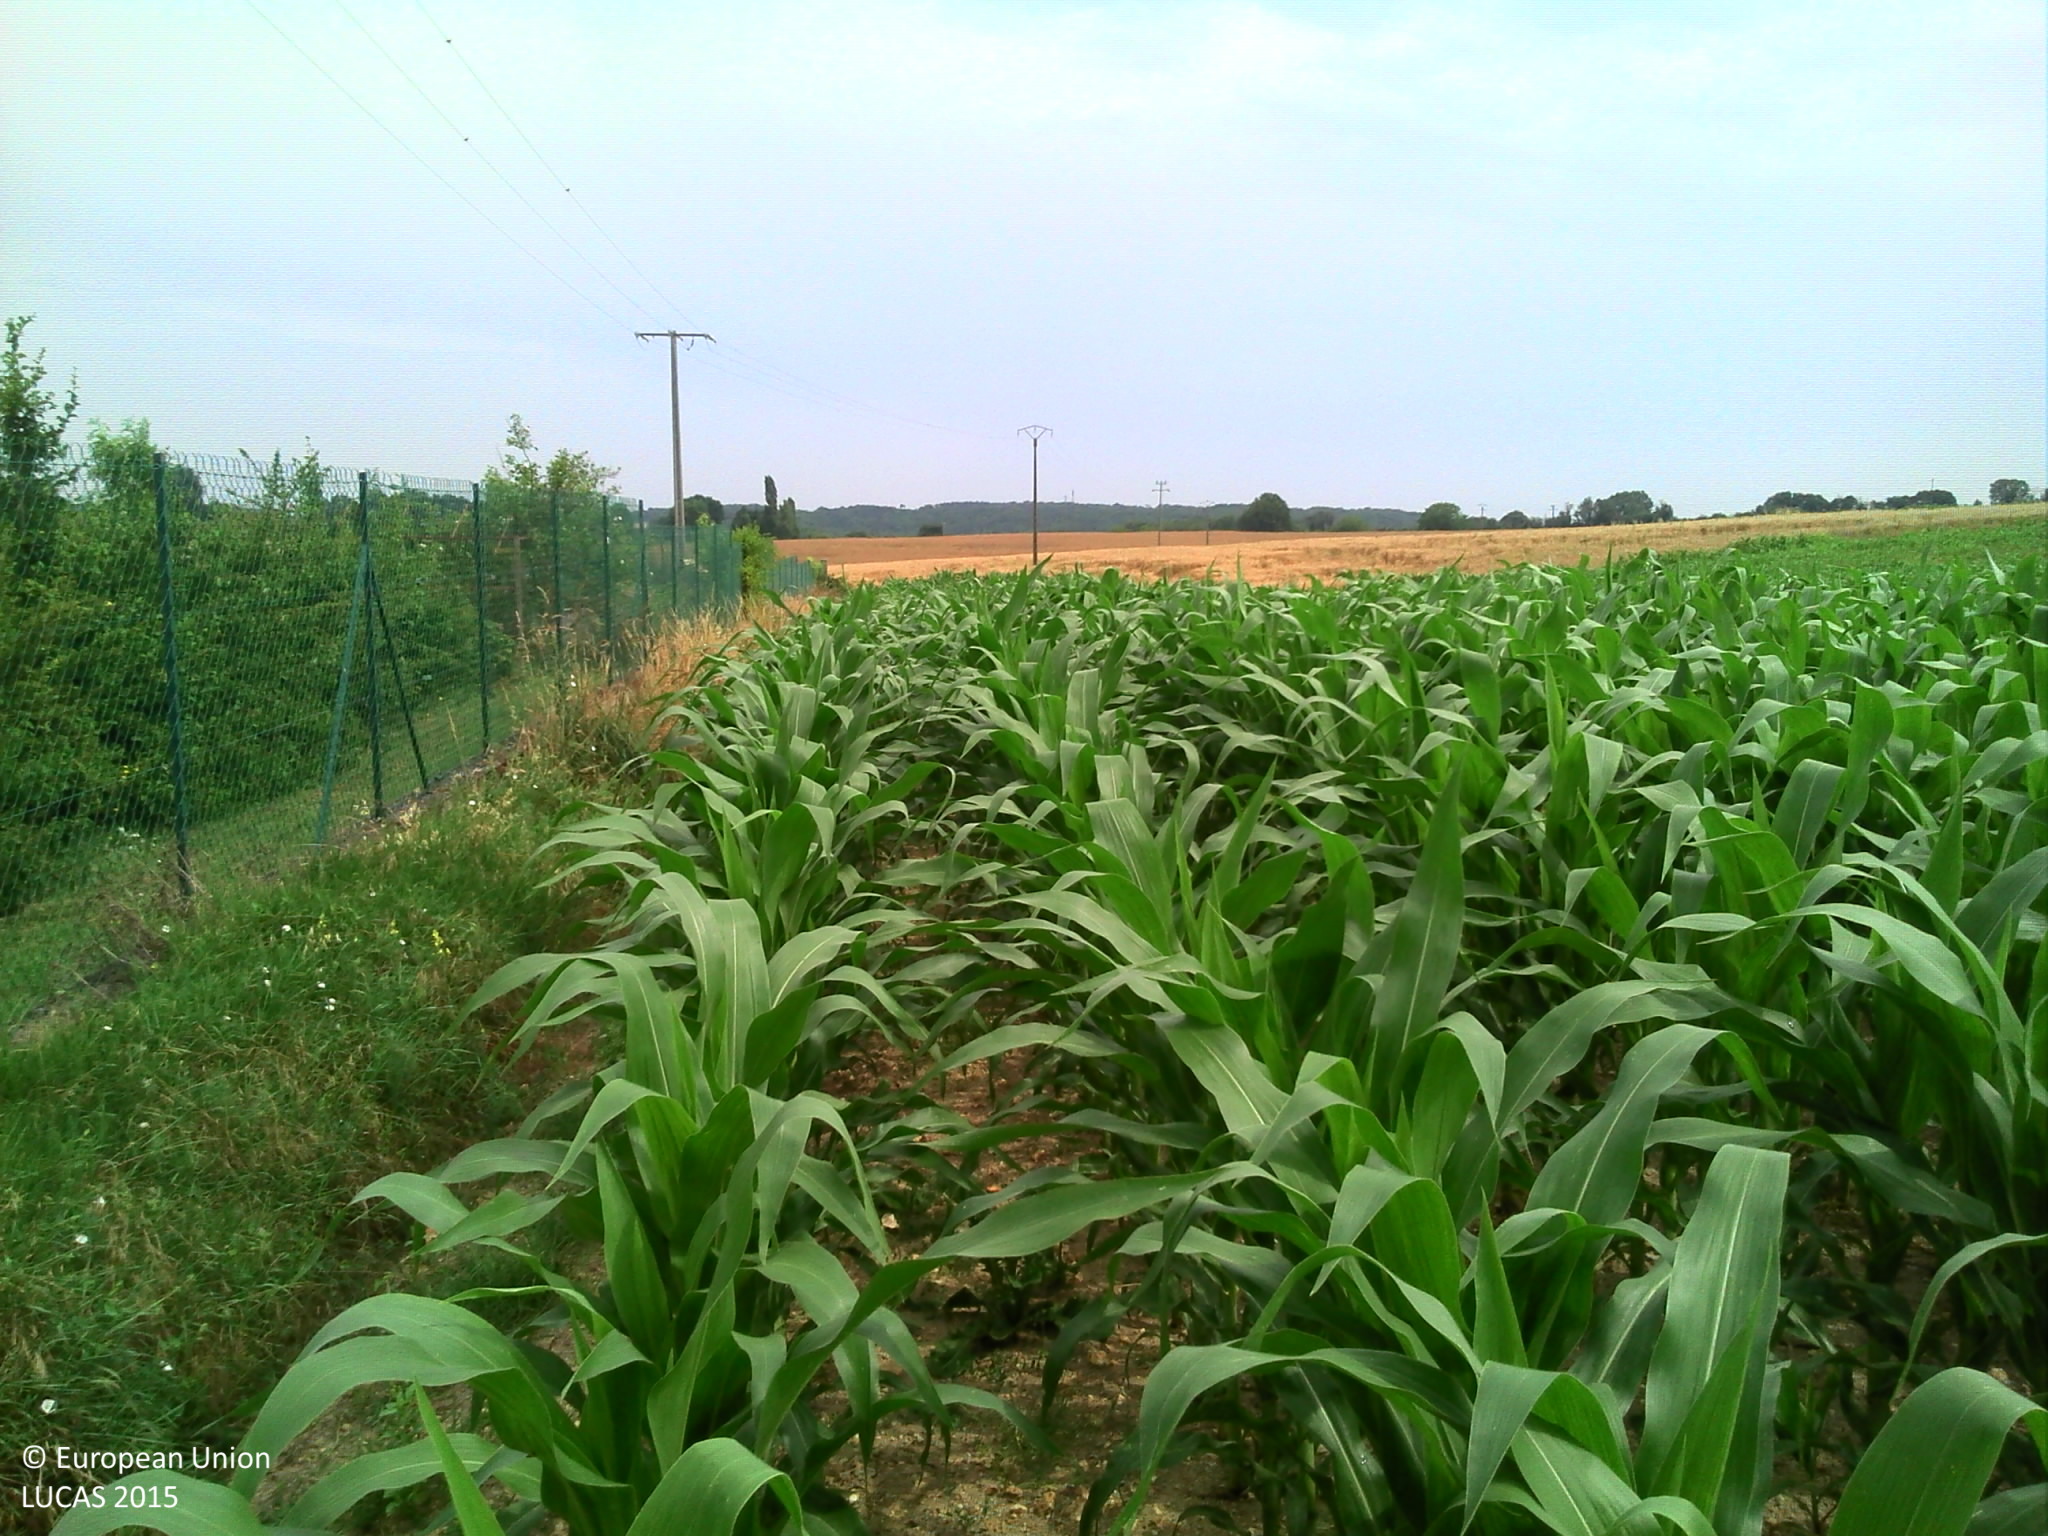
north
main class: Grassland
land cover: Grassland without tree/shrub cover
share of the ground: > 75 %
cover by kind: herbaceous plants 100 %
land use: Residential
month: July
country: FR
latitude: 46.4640
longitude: 0.6211
